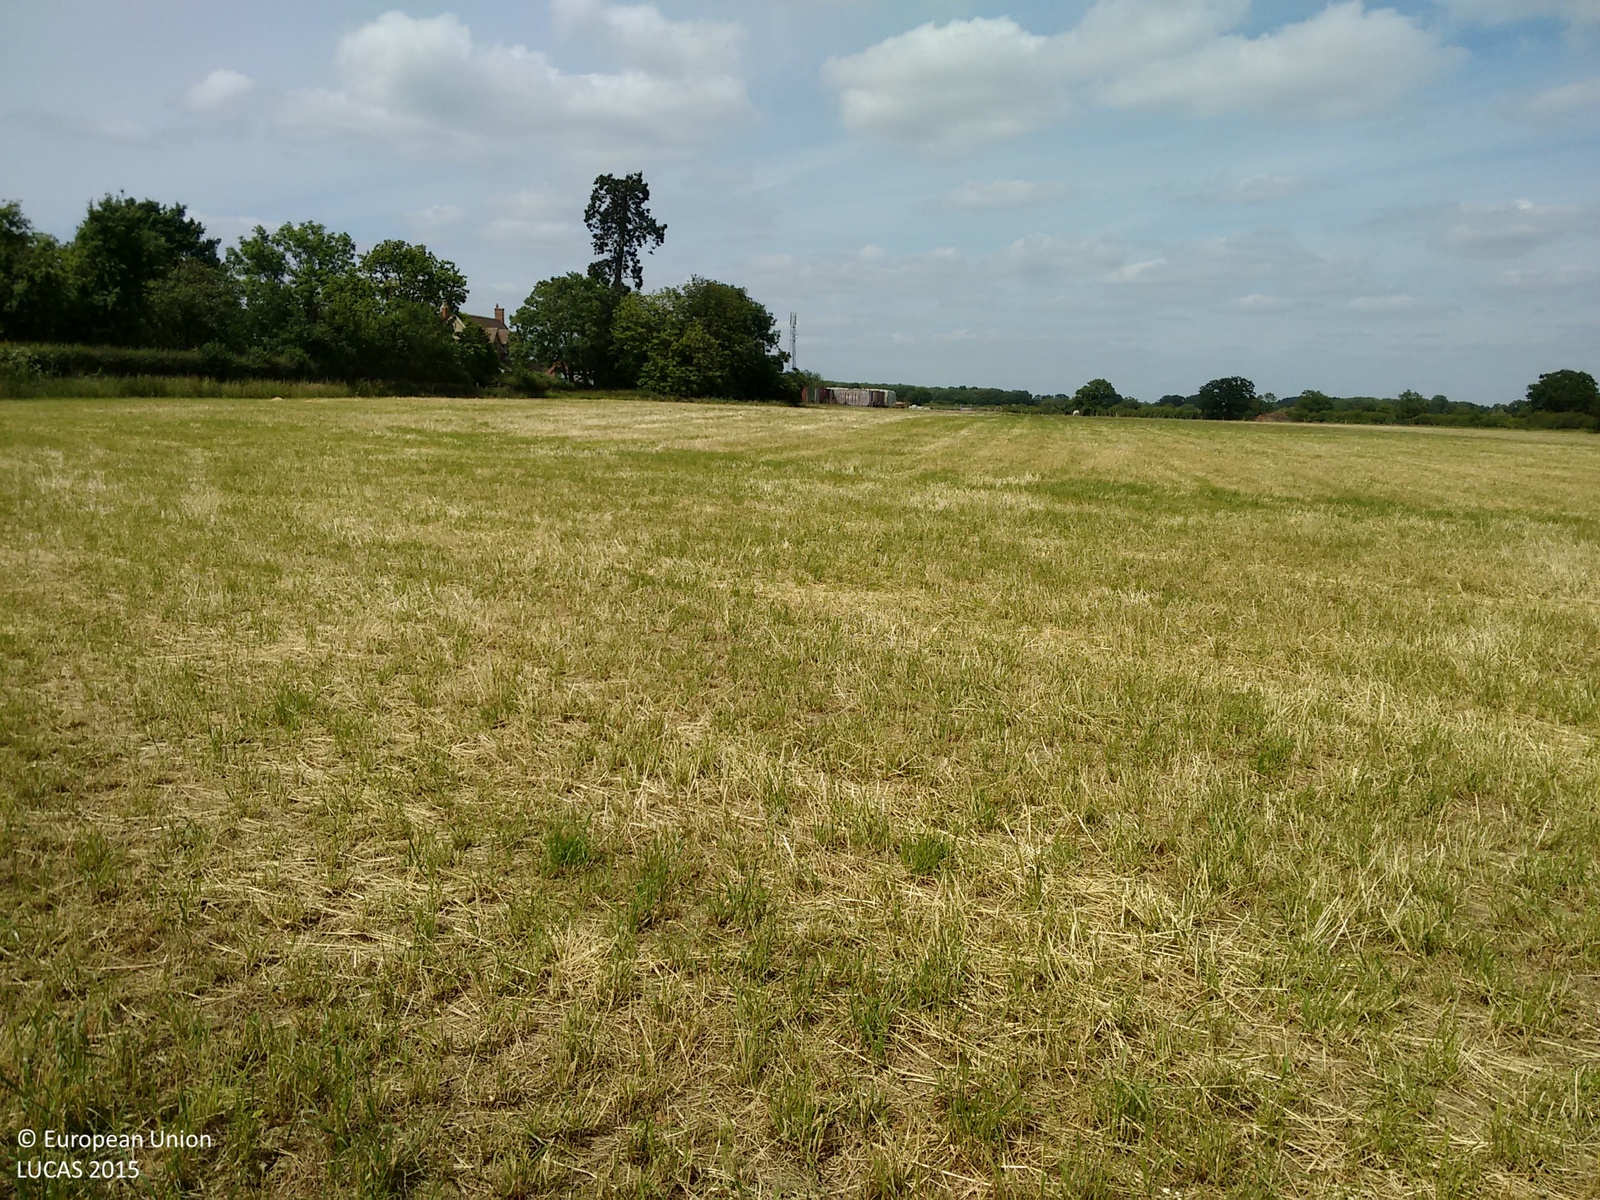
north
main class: Grassland
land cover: Grassland without tree/shrub cover
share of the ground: > 75 %
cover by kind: herbaceous plants 100 %
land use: Agriculture (excluding fallow land and kitchen gardens)
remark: Harvested field
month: June
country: GB
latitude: 51.8447
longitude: -1.2096
